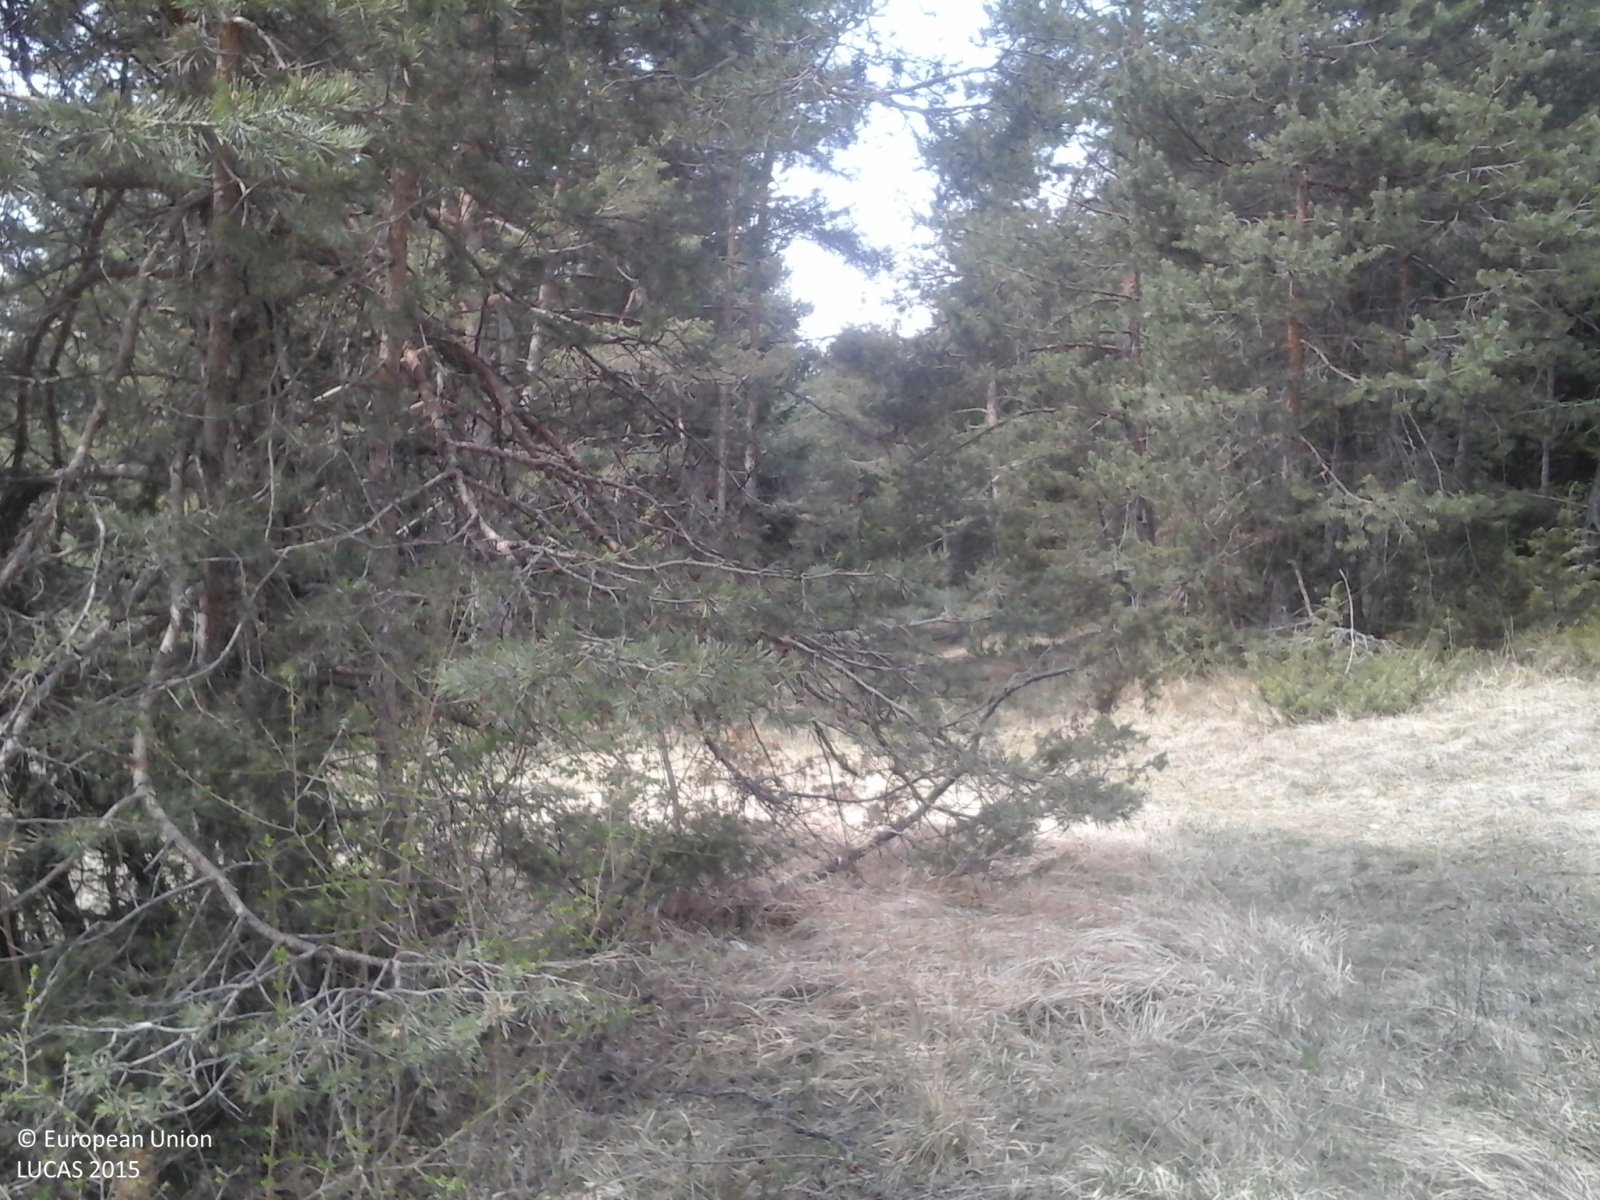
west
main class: Woodland
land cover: Pine dominated coniferous woodland
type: alpine coniferous forest
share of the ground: 50 - 75 %
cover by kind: coniferous forest trees 60 %, herbaceous plants 35 %, shrubs 5 %
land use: Forestry
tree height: > 5 m
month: April
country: IT
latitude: 46.3452
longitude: 11.1290
